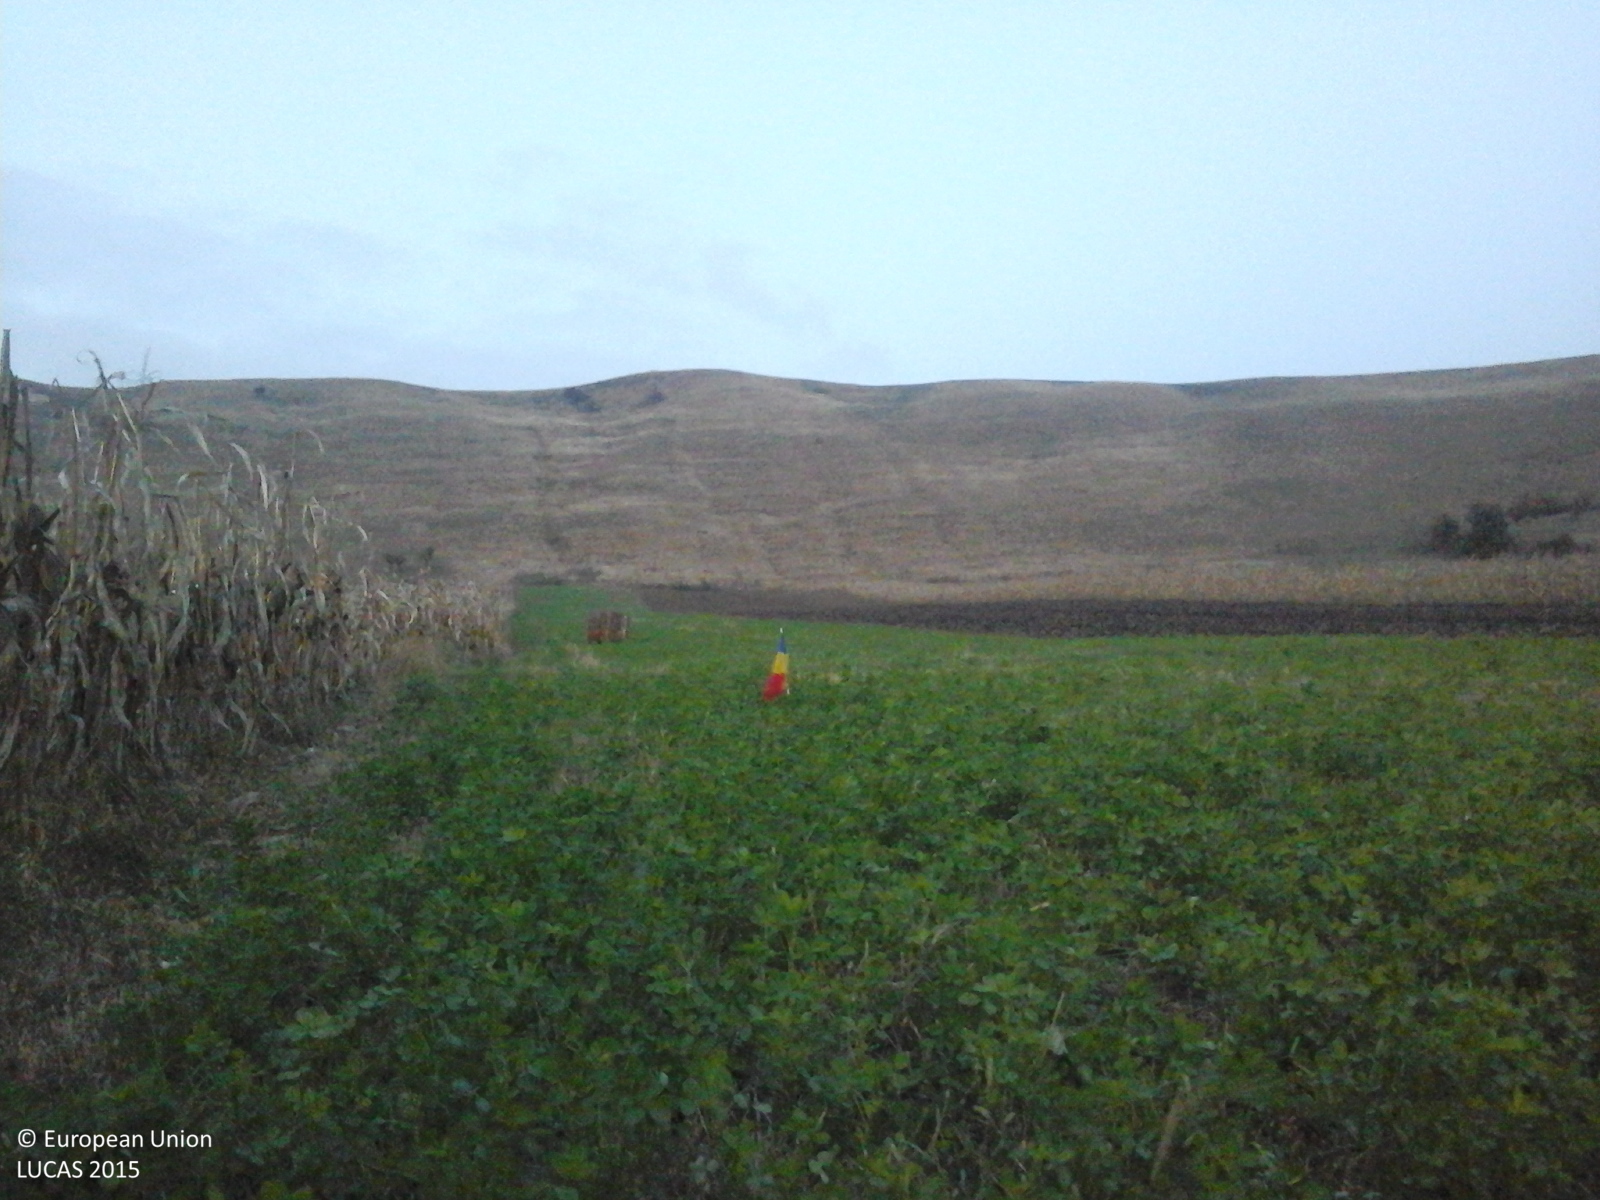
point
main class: Cropland
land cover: Lucerne
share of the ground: > 75 %
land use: Agriculture (excluding fallow land and kitchen gardens)
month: October
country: RO
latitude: 46.3573
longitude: 23.9949
